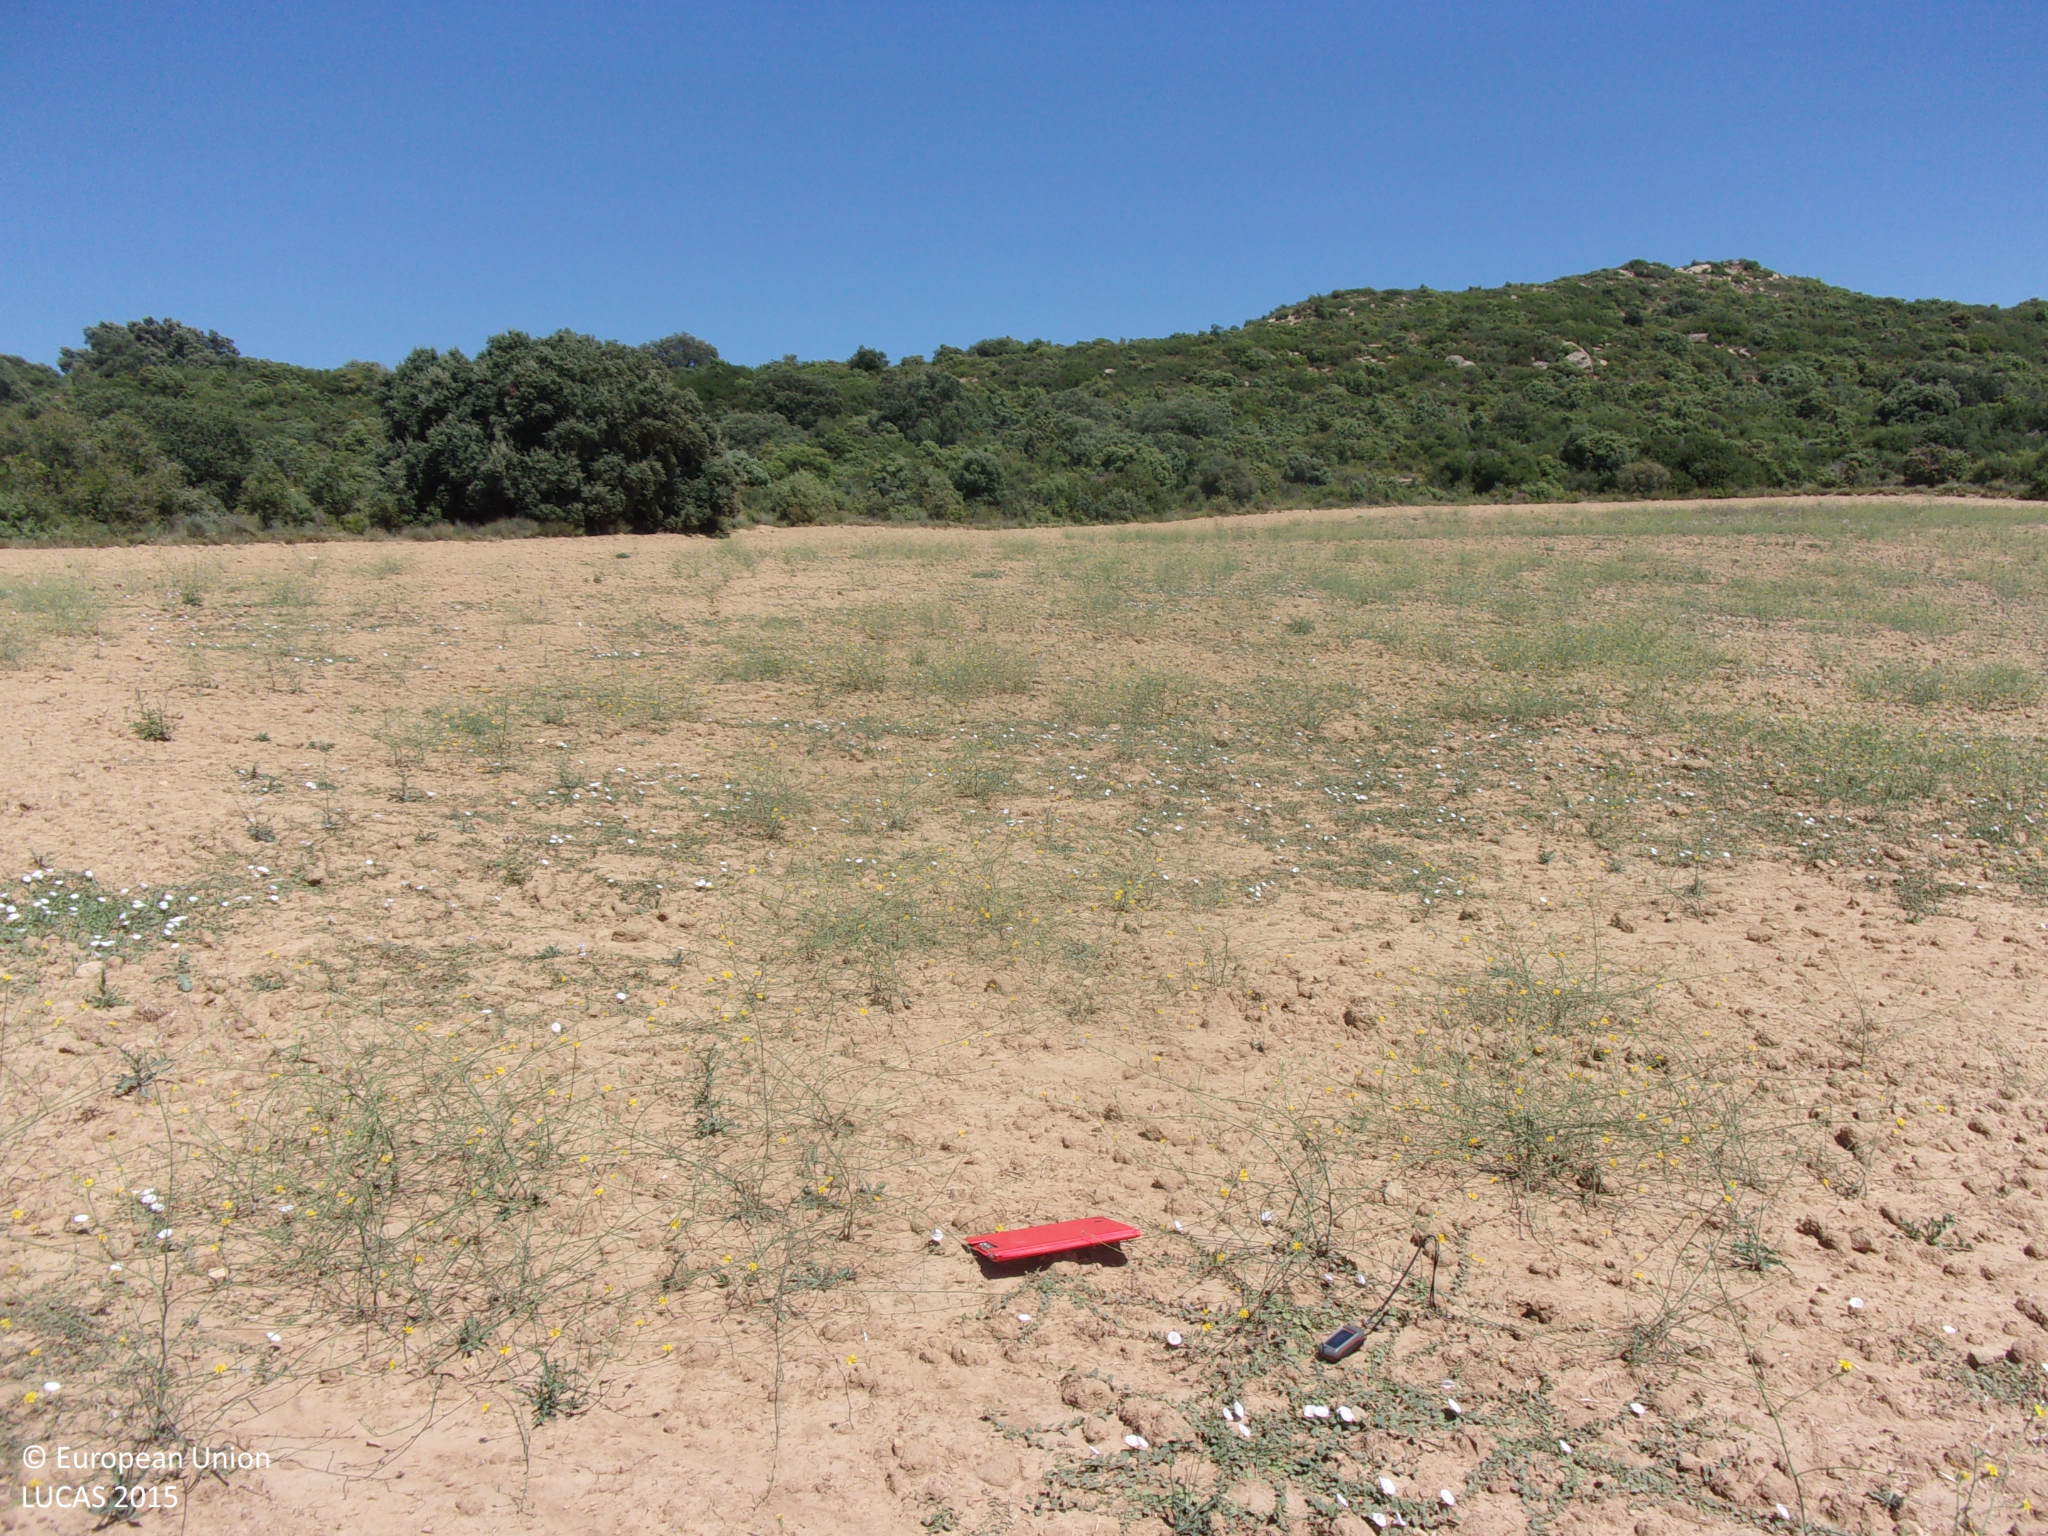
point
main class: Grassland
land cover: Spontaneously vegetated surfaces
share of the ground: 25 - 50 %
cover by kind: unconsolidated bare surface 70 %, herbaceous plants 30 %
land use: Fallow land
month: August
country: ES
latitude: 42.3600
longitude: -1.1887
